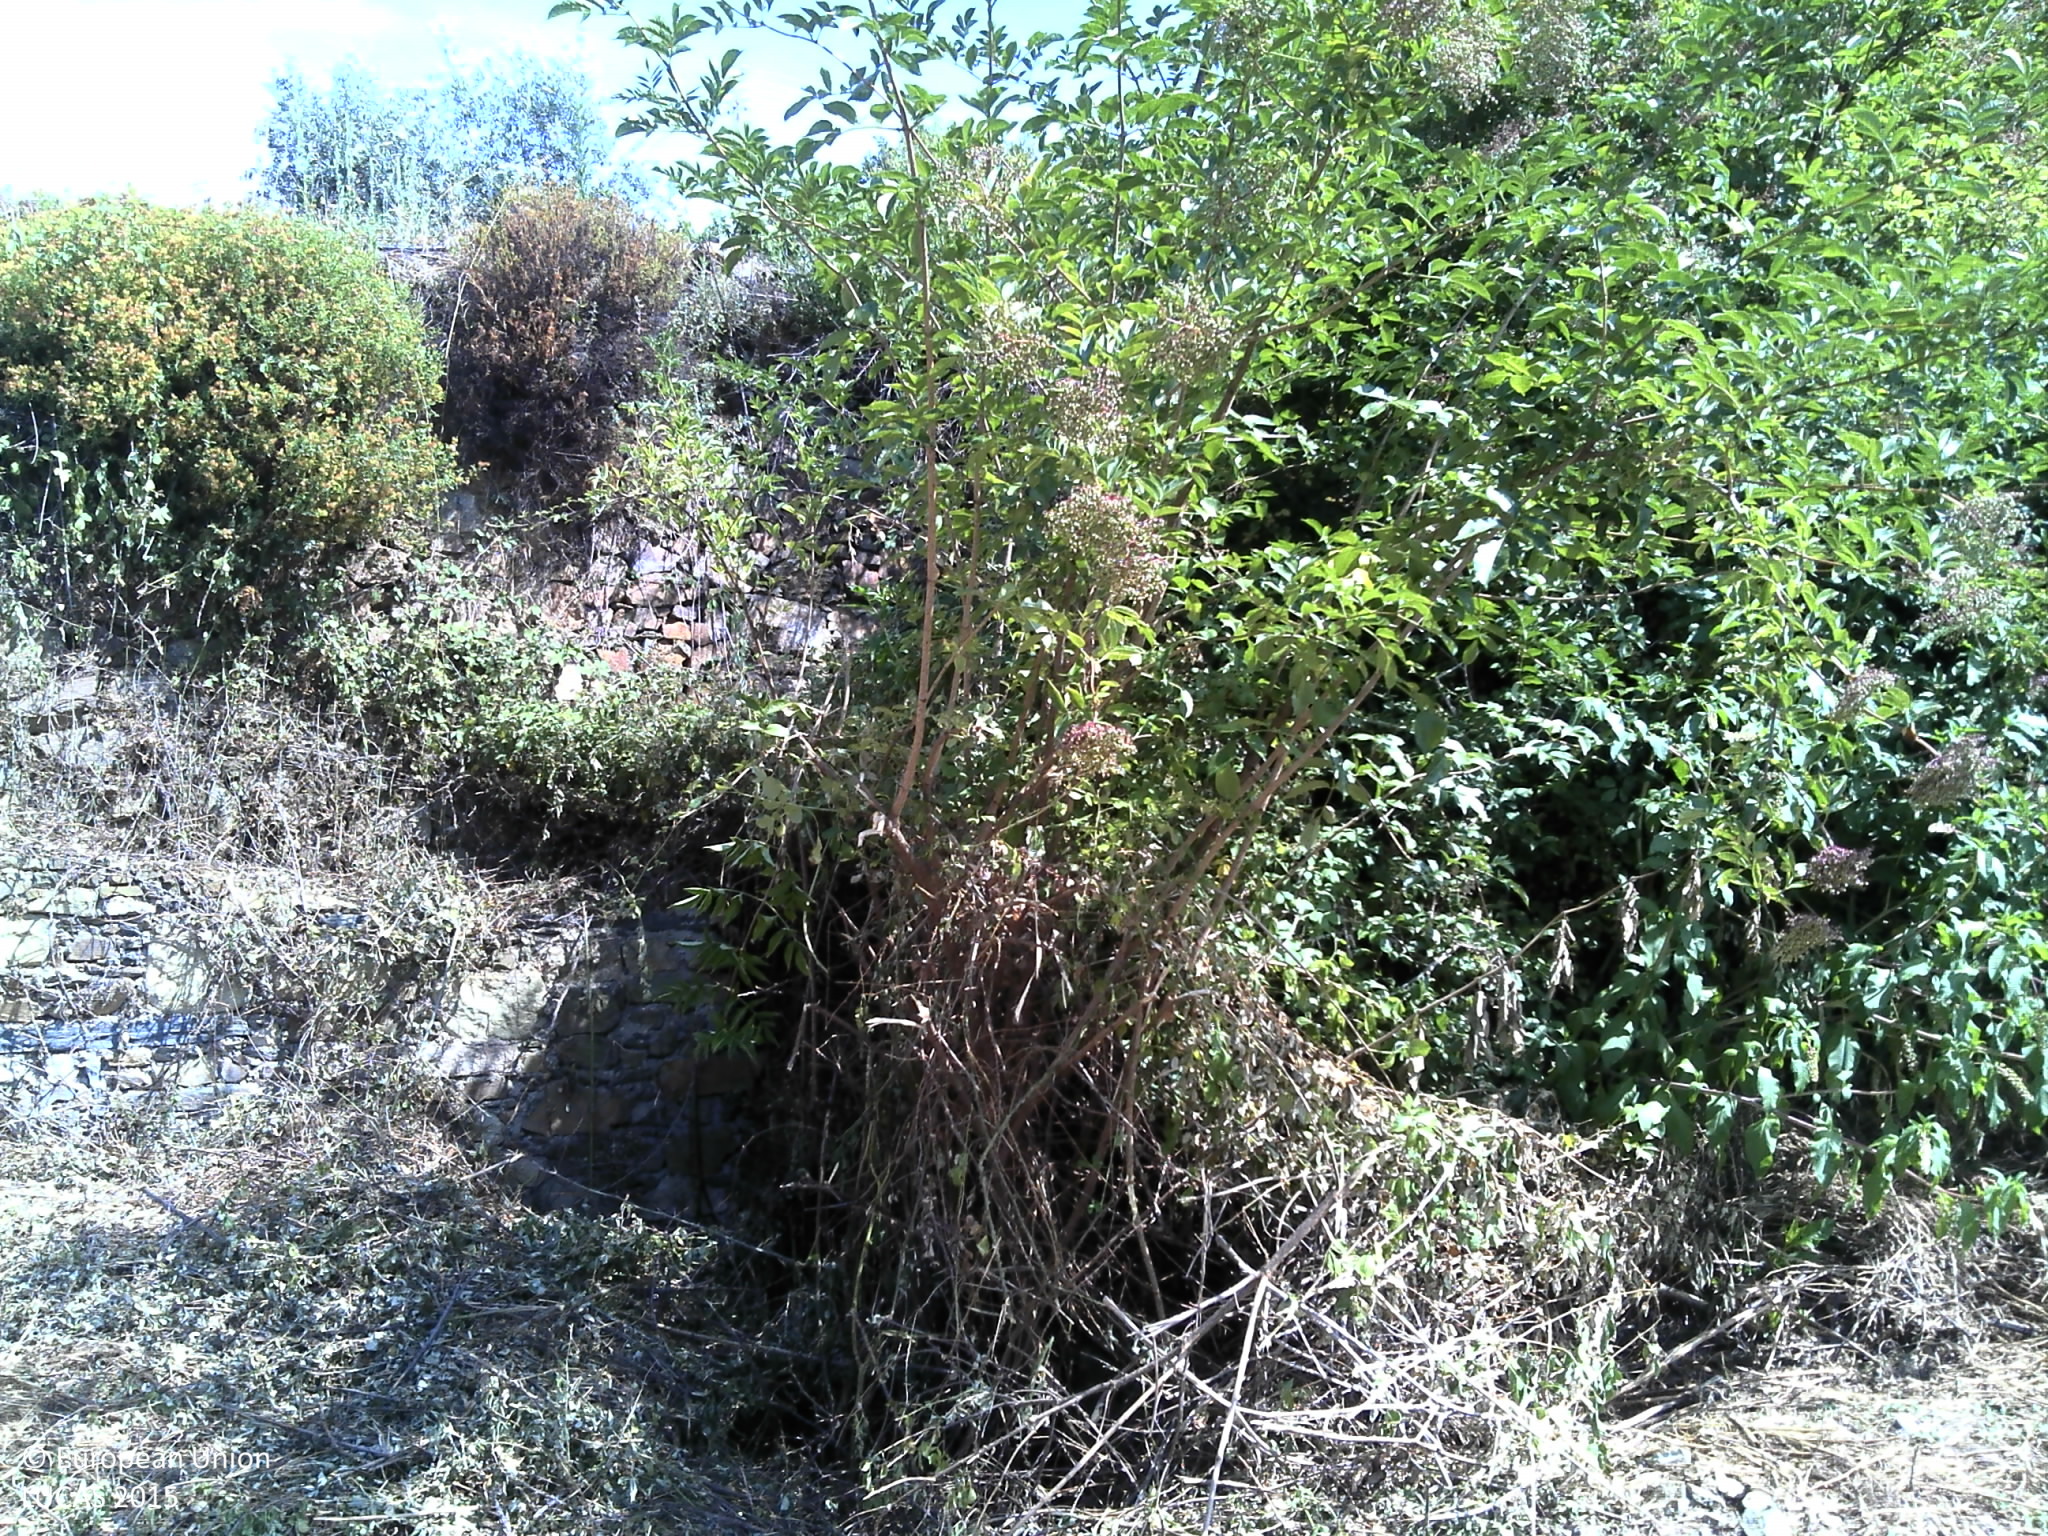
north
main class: Cropland
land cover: Olive groves
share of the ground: < 10 %
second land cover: Grassland without tree/shrub cover
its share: > 75 %
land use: Agriculture (excluding fallow land and kitchen gardens)
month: July
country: PT
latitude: 39.7981
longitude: -7.8478
